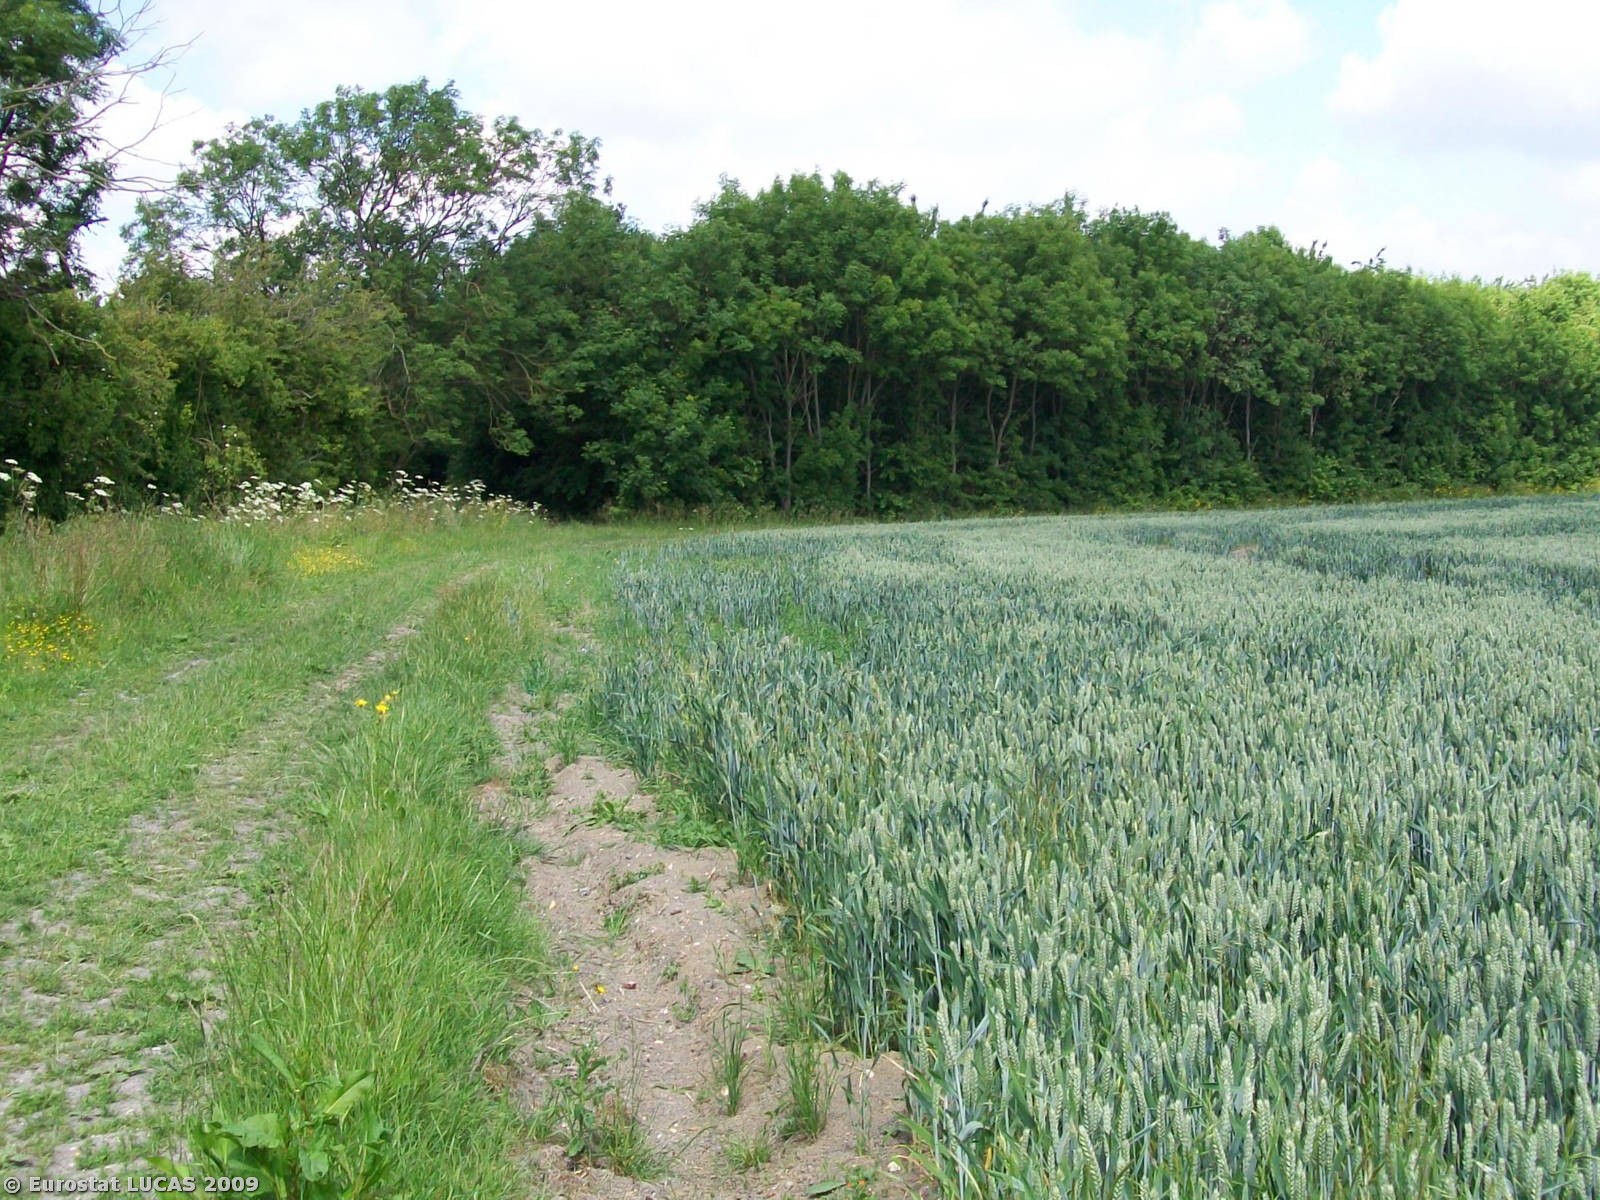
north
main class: Cropland
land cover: Common wheat
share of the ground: > 75 %
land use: Agriculture (excluding fallow land and kitchen gardens)
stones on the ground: < 10 %
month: June
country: GB
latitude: 52.1571
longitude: 0.0427
